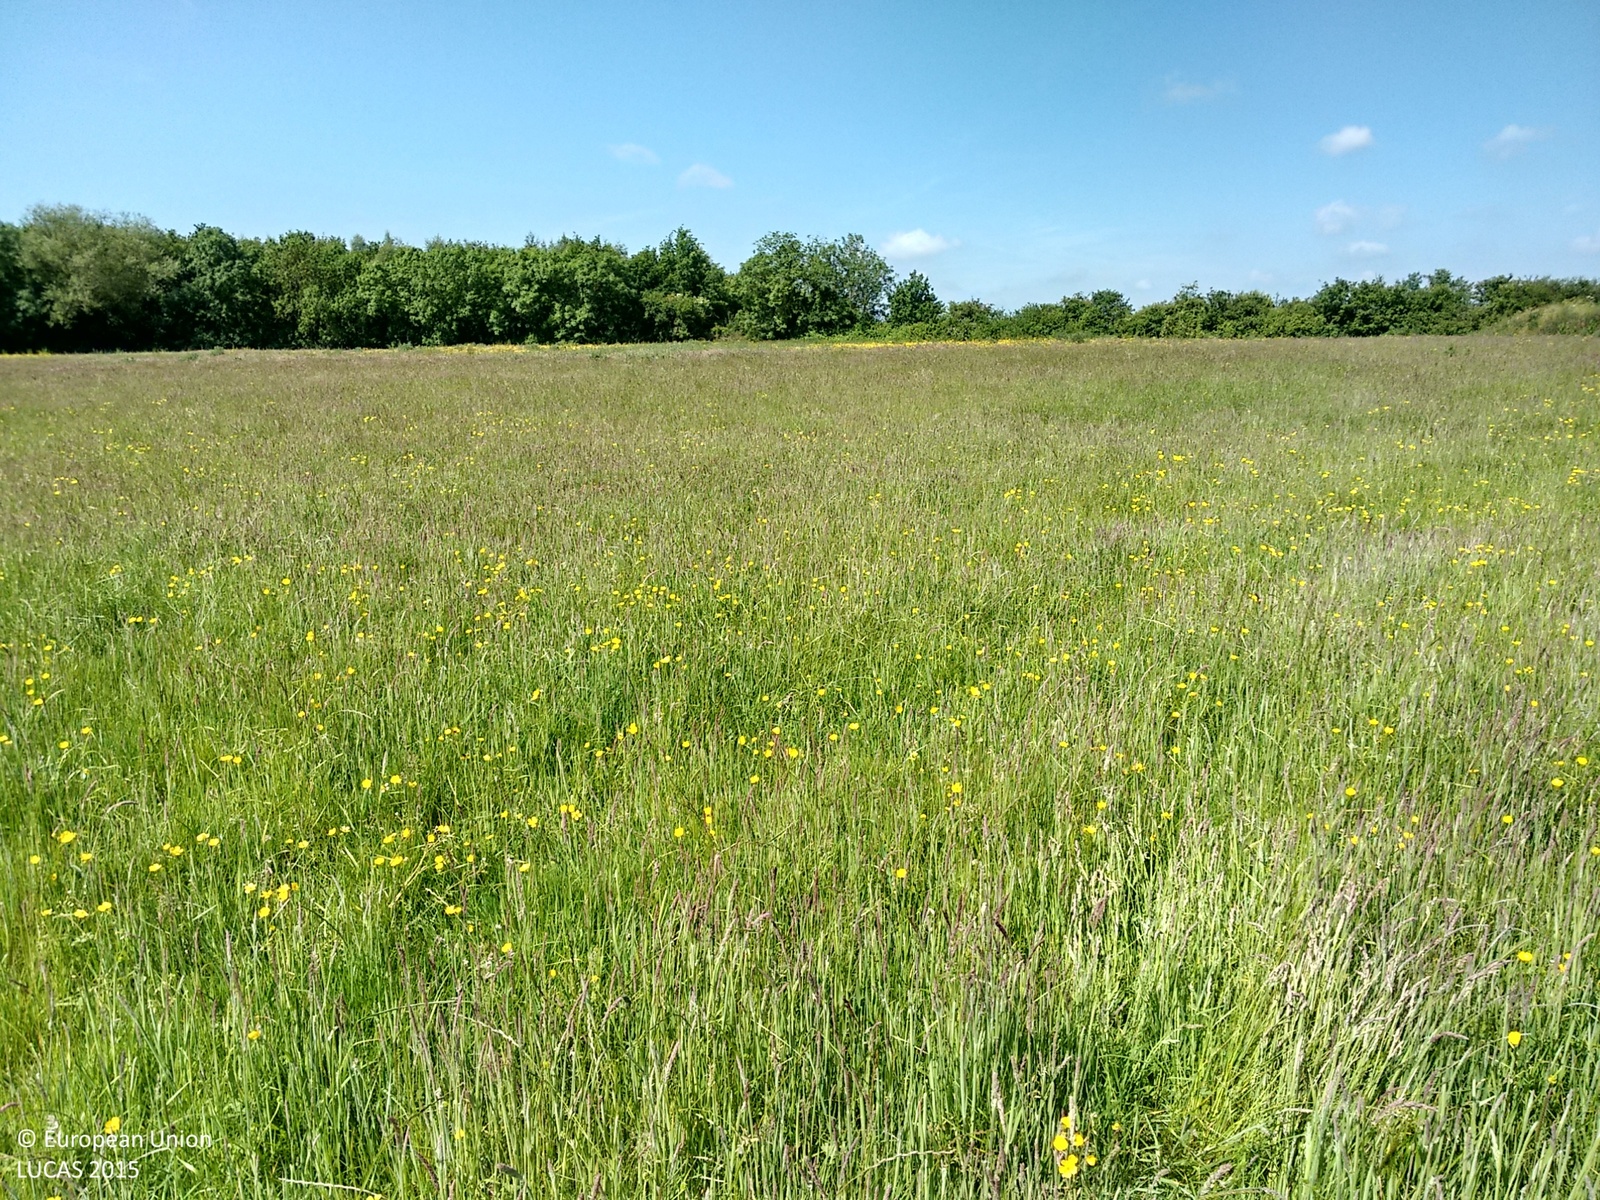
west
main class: Grassland
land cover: Grassland without tree/shrub cover
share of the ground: > 75 %
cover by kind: herbaceous plants 100 %
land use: Agriculture (excluding fallow land and kitchen gardens)
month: June
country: GB
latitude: 52.0272
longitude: -0.8127
